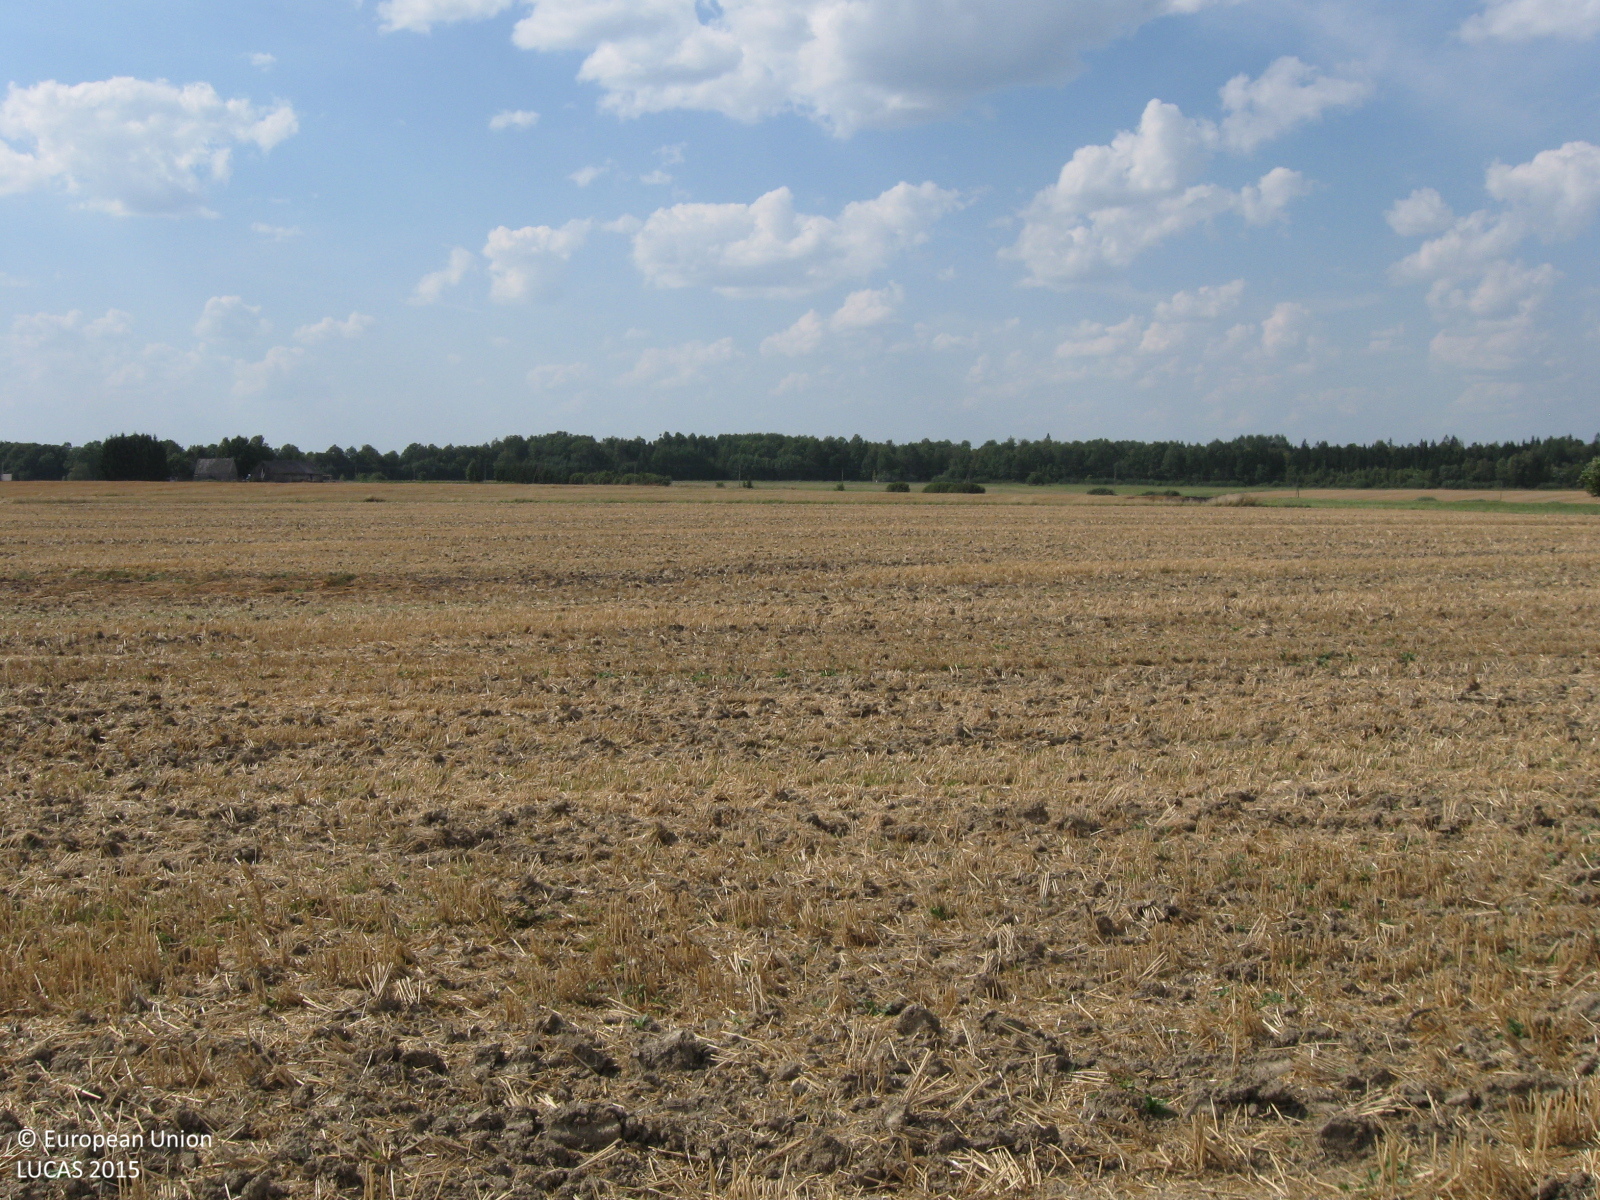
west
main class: Cropland
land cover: Common wheat
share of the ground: < 10 %
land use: Agriculture (excluding fallow land and kitchen gardens)
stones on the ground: < 10 %
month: August
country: LT
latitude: 55.5169
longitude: 22.8800
